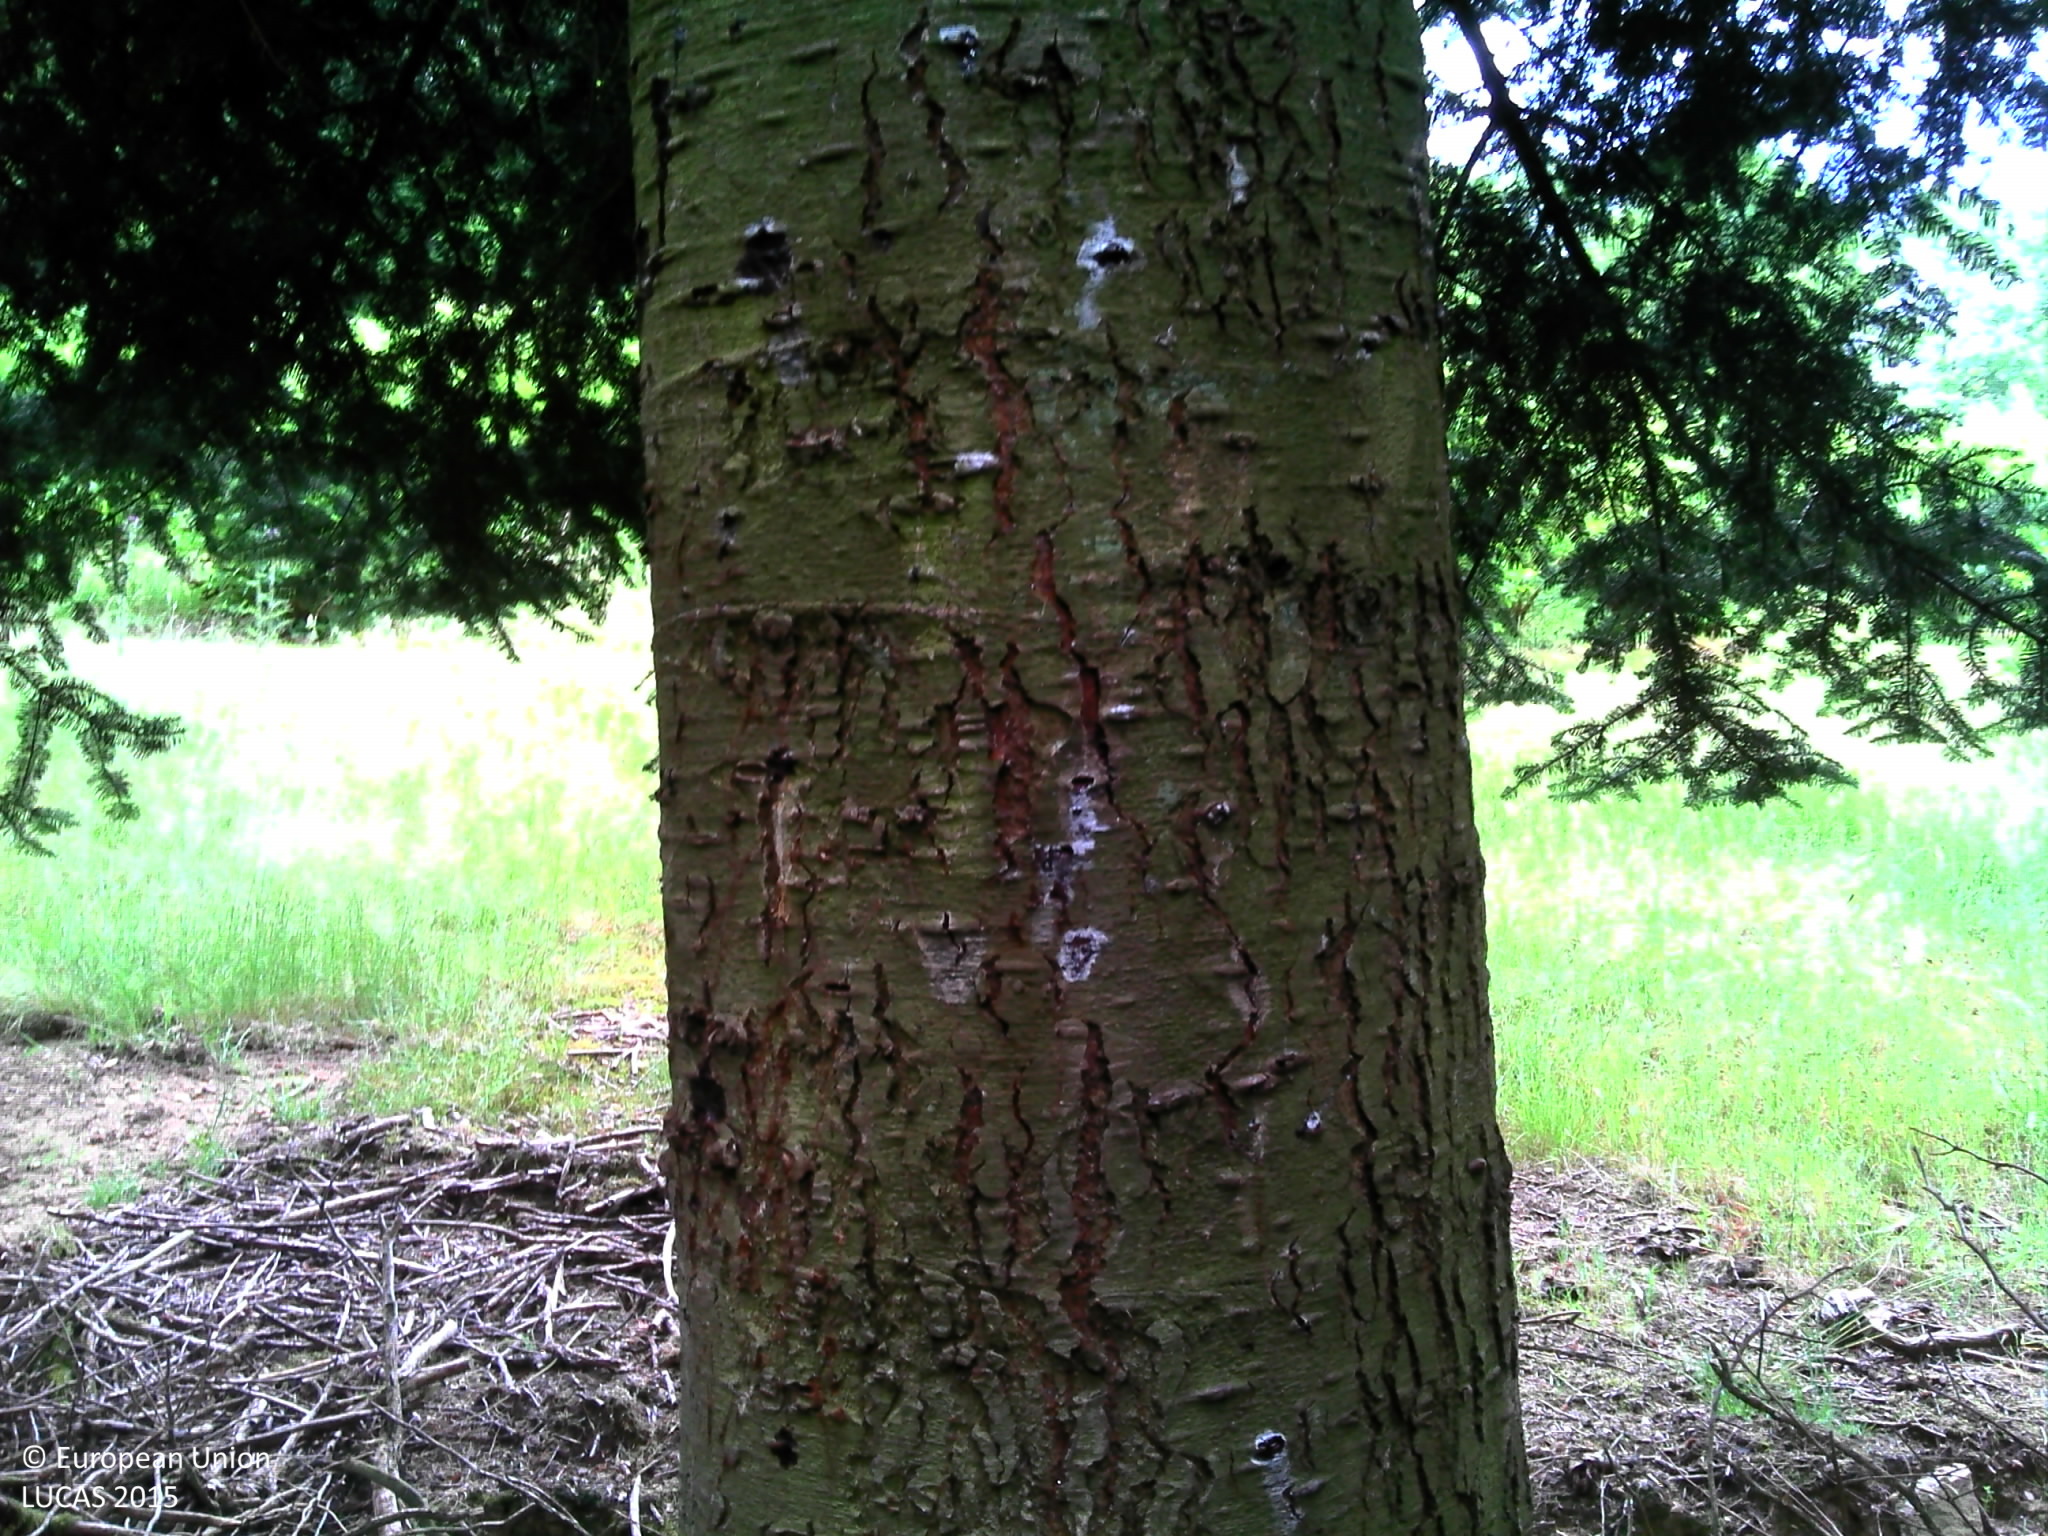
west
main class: Woodland
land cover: Other coniferous woodland
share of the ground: > 75 %
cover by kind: coniferous forest trees 80 %, unconsolidated bare surface 20 %
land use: Forestry
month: July
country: BE
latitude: 50.3081
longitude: 5.8848
